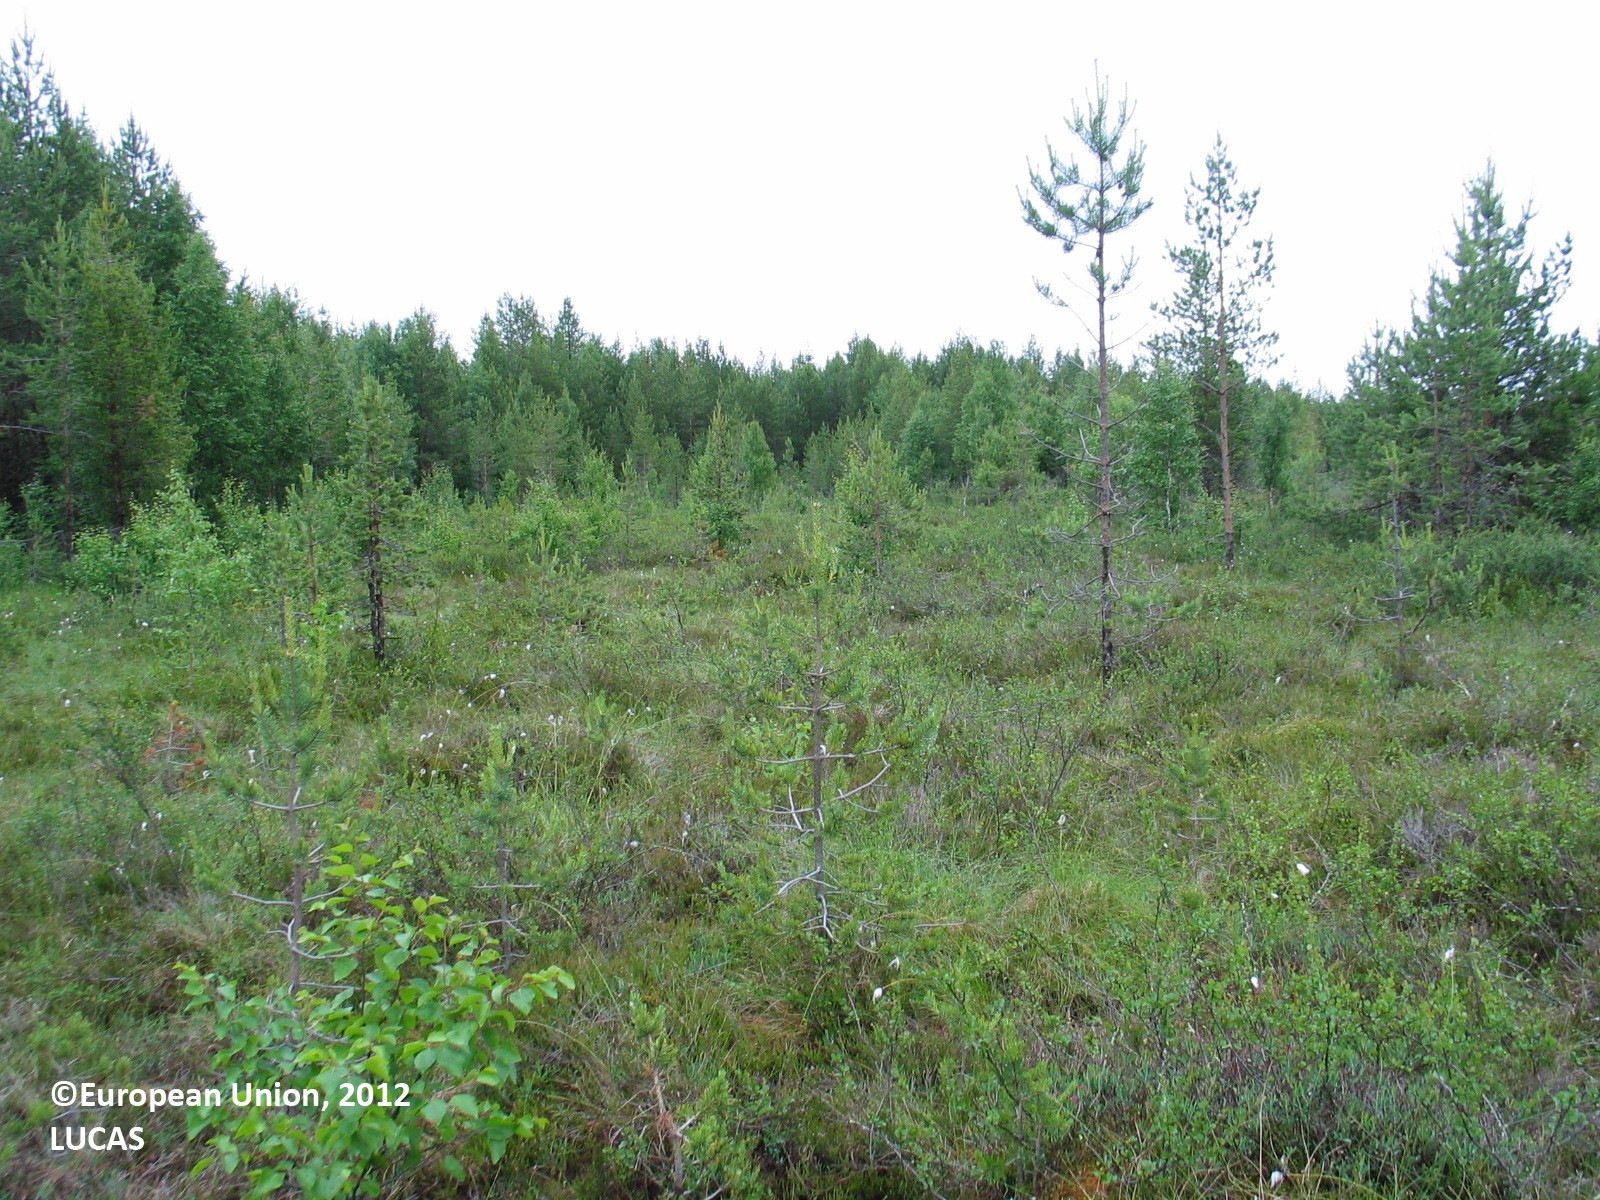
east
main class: Woodland
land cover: Pine dominated coniferous woodland
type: mire and swamp forests
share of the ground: 10 - 25 %
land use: Semi-natural and natural areas not in use
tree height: < 5 m
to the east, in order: Pine dominated coniferous woodland; Other mixed woodland; Pine dominated coniferous woodland; Other mixed woodland; Ditches and canals; Other mixed woodland
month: July
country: FI
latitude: 66.0229
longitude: 25.0349
